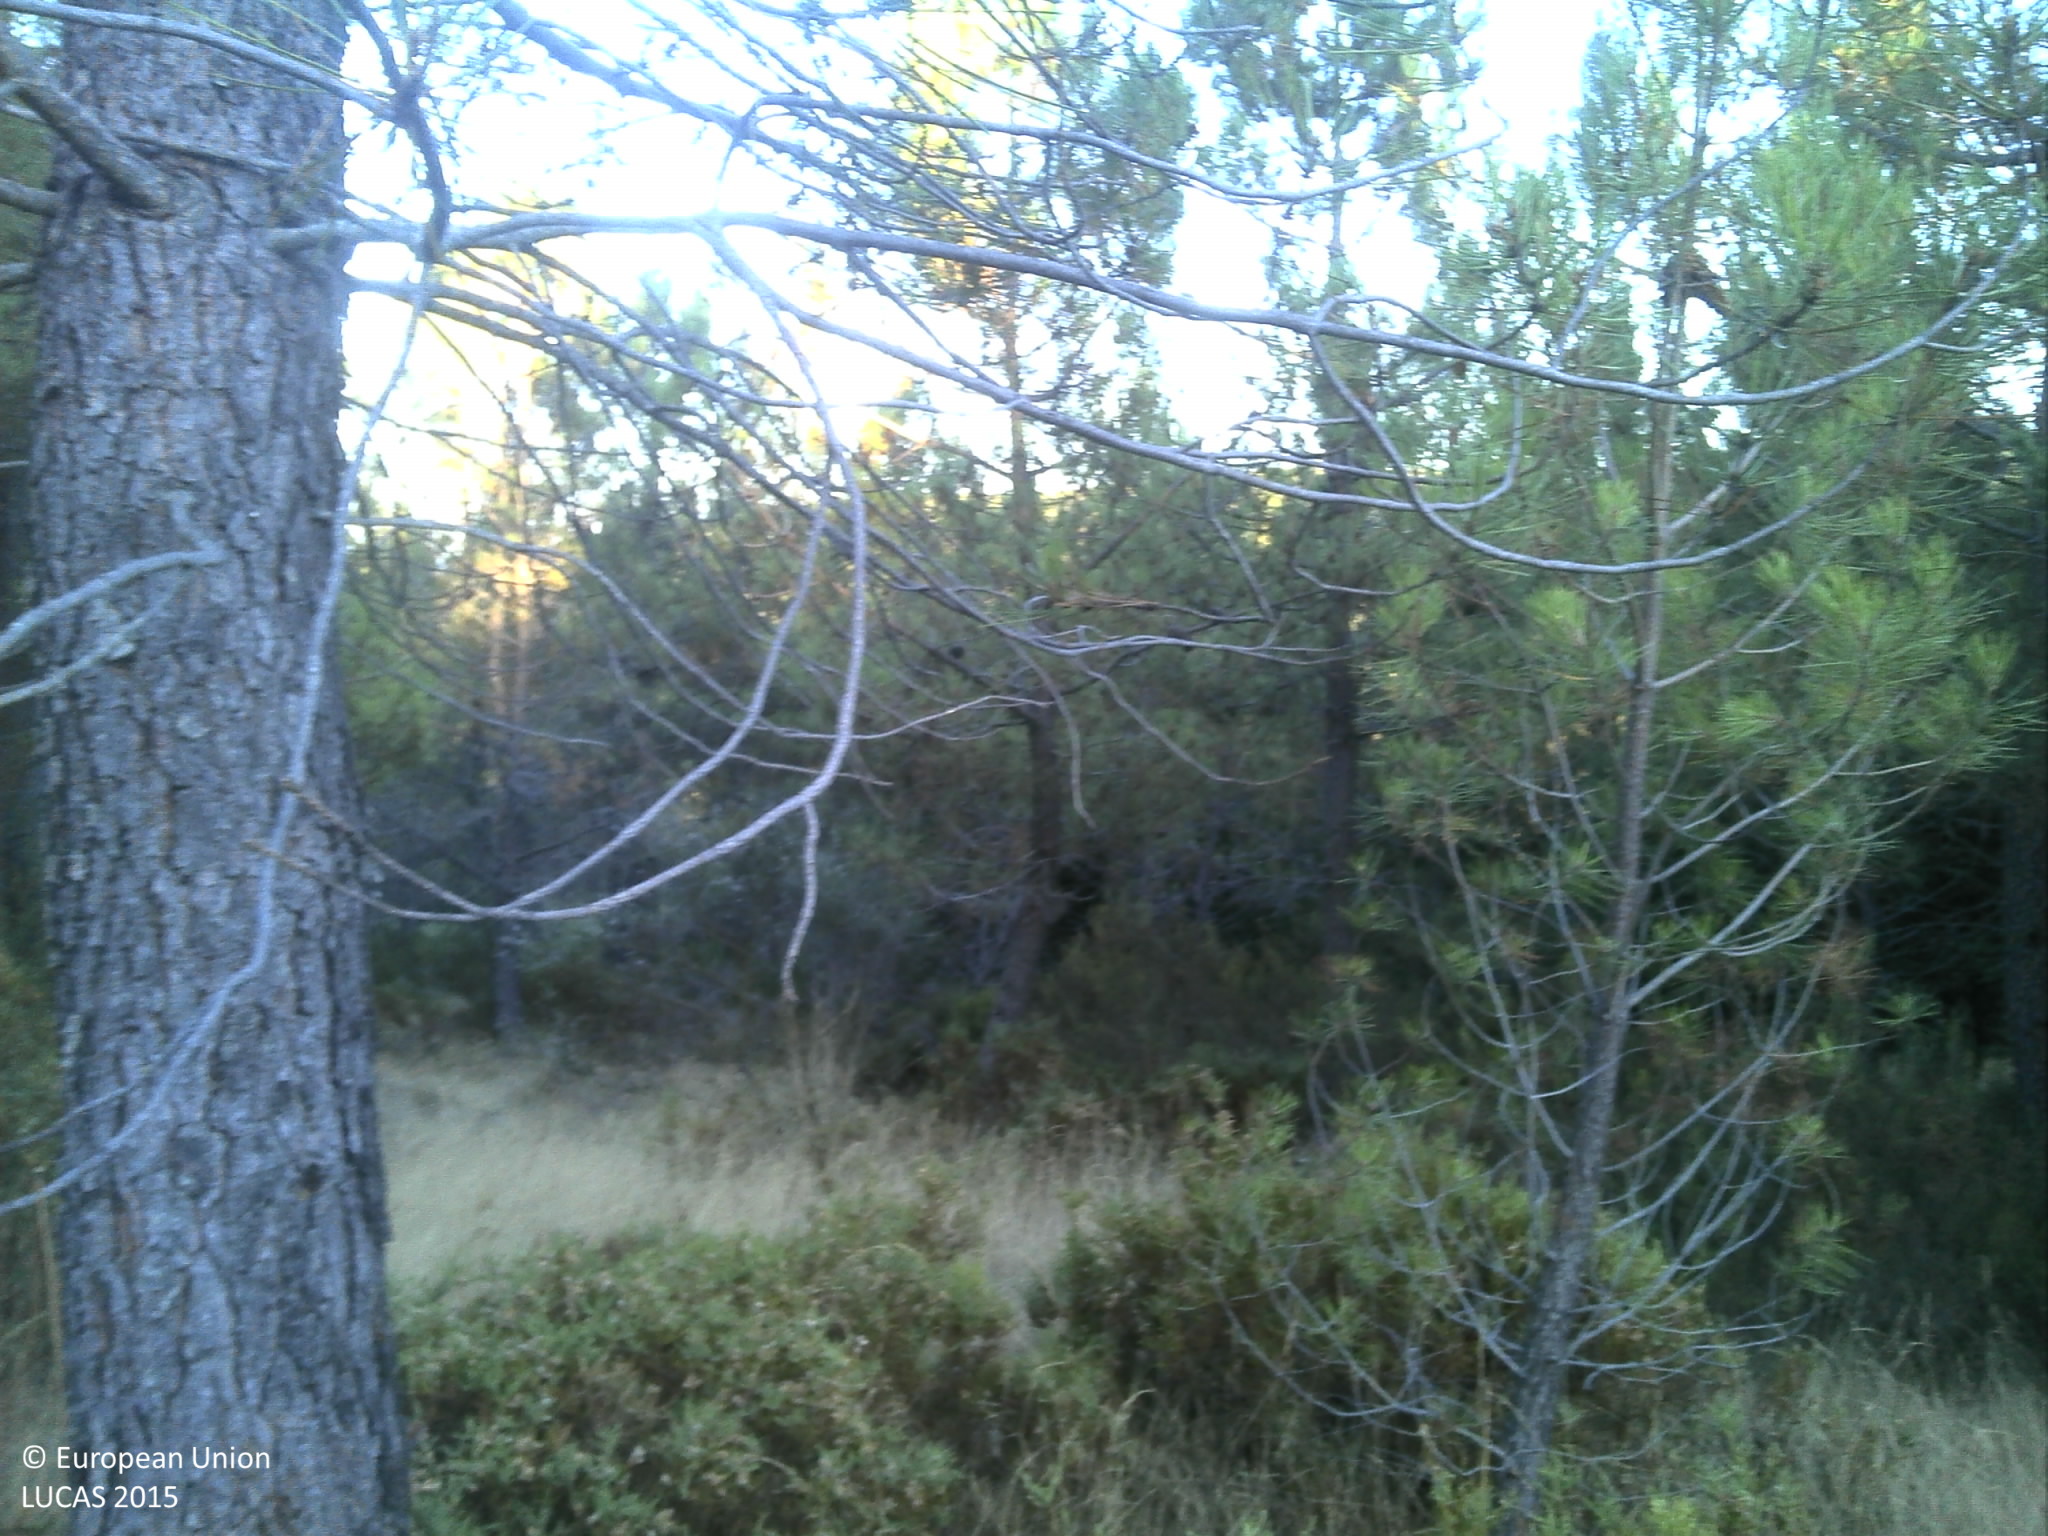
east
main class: Woodland
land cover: Pine dominated coniferous woodland
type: coniferous forest of the mediterranean region
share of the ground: 50 - 75 %
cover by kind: coniferous forest trees 60 %, shrubs 15 %, unconsolidated bare surface 15 %
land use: Forestry
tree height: > 5 m
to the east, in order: Pine dominated coniferous woodland; Tracks; Pine dominated coniferous woodland; Shrubland without tree cover
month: August
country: PT
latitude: 40.4427
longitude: -7.4515
